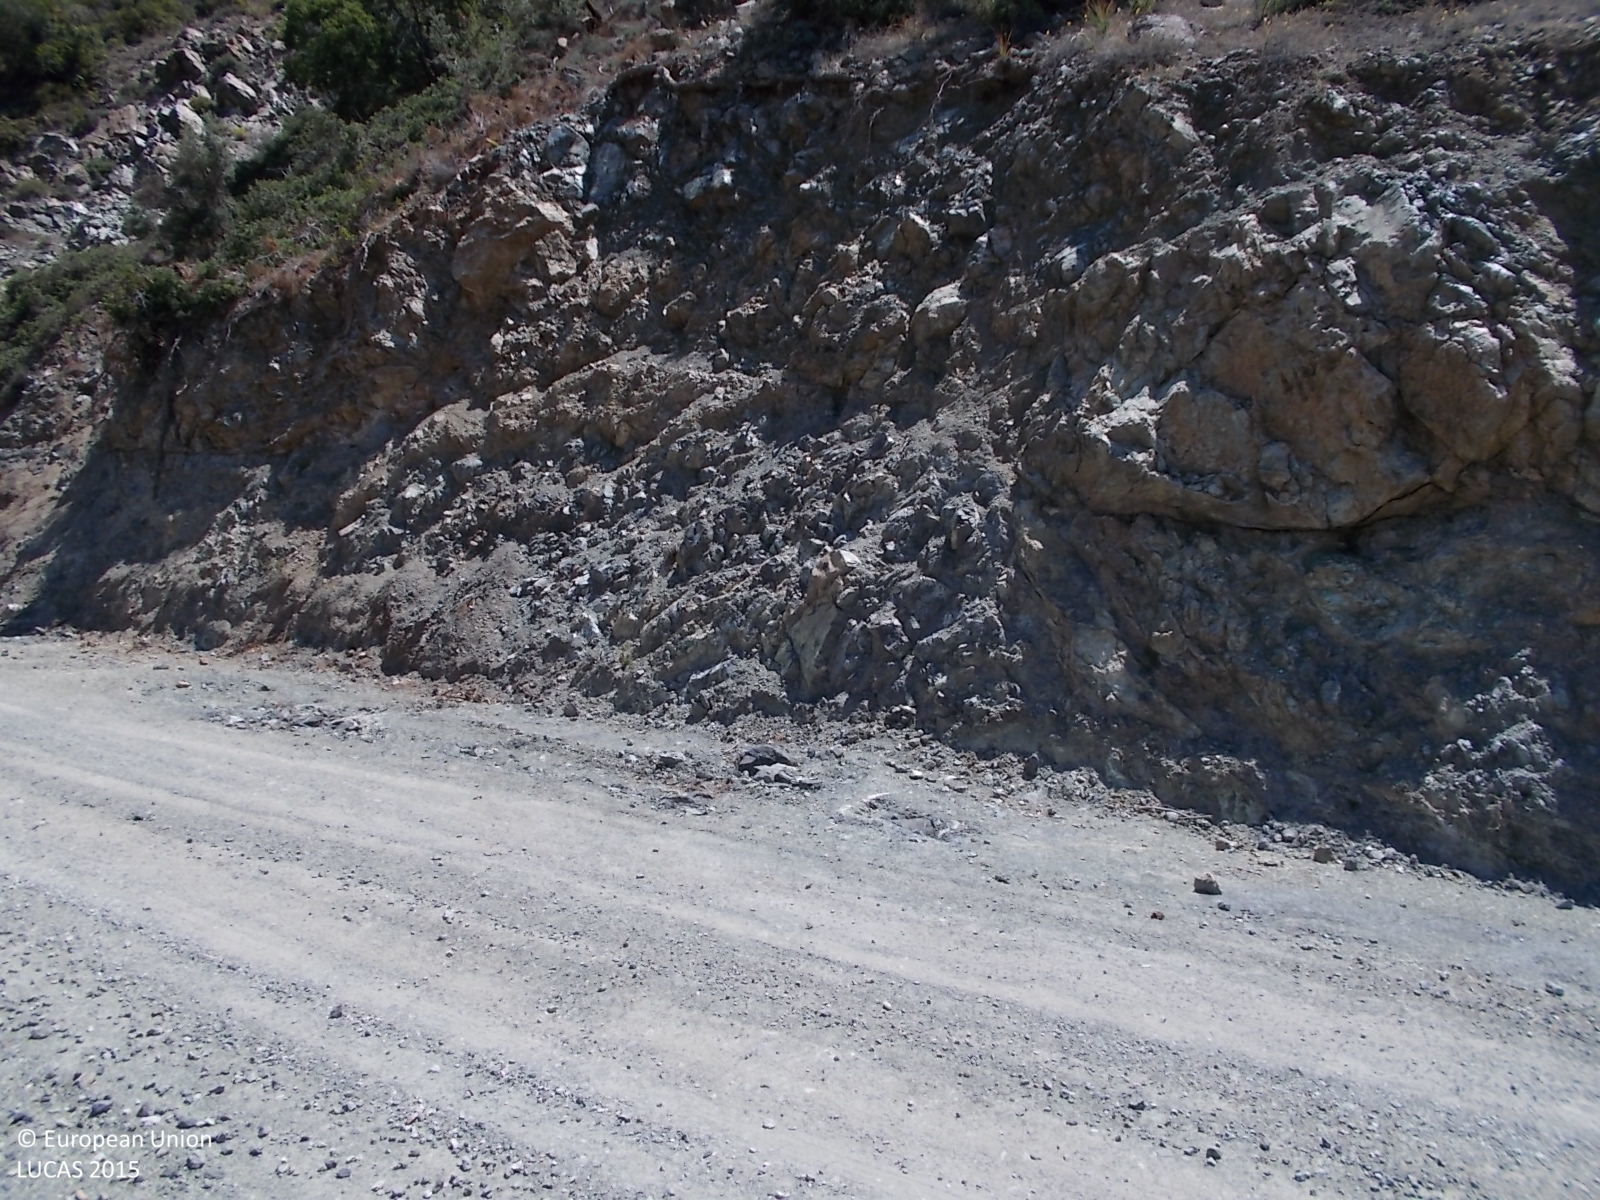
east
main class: Woodland
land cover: Pine dominated coniferous woodland
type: coniferous forest of the mediterranean region
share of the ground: 25 - 50 %
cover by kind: unconsolidated bare surface 55 %, coniferous forest trees 45 %
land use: Forestry
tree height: > 5 m
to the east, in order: Pine dominated coniferous woodland; Rocks and stones; Pine dominated coniferous woodland; Inland fresh running water; Pine dominated coniferous woodland
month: May
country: CY
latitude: 34.8063
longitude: 33.0252
